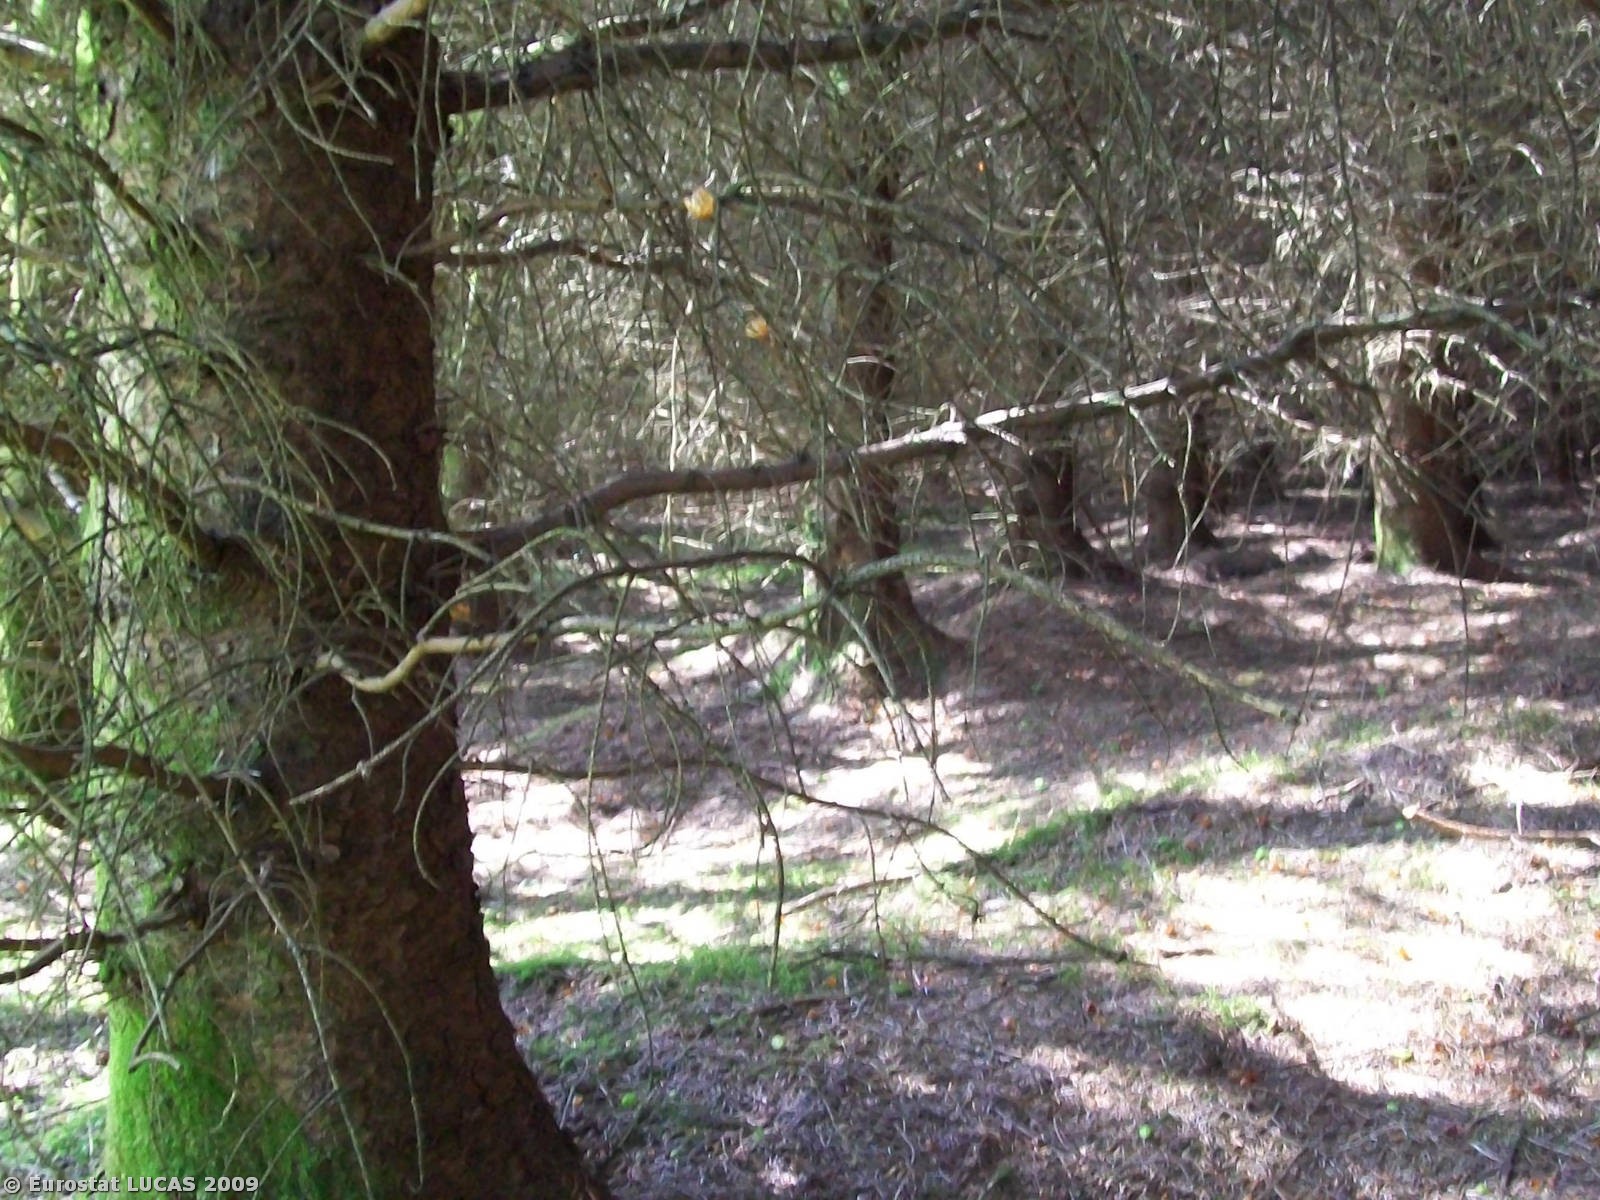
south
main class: Woodland
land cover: Coniferous woodland
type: plantations and self-sown exotic forest
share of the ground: > 75 %
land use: Forestry
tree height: > 5 m
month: May
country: GB
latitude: 55.0973
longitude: -6.8539
